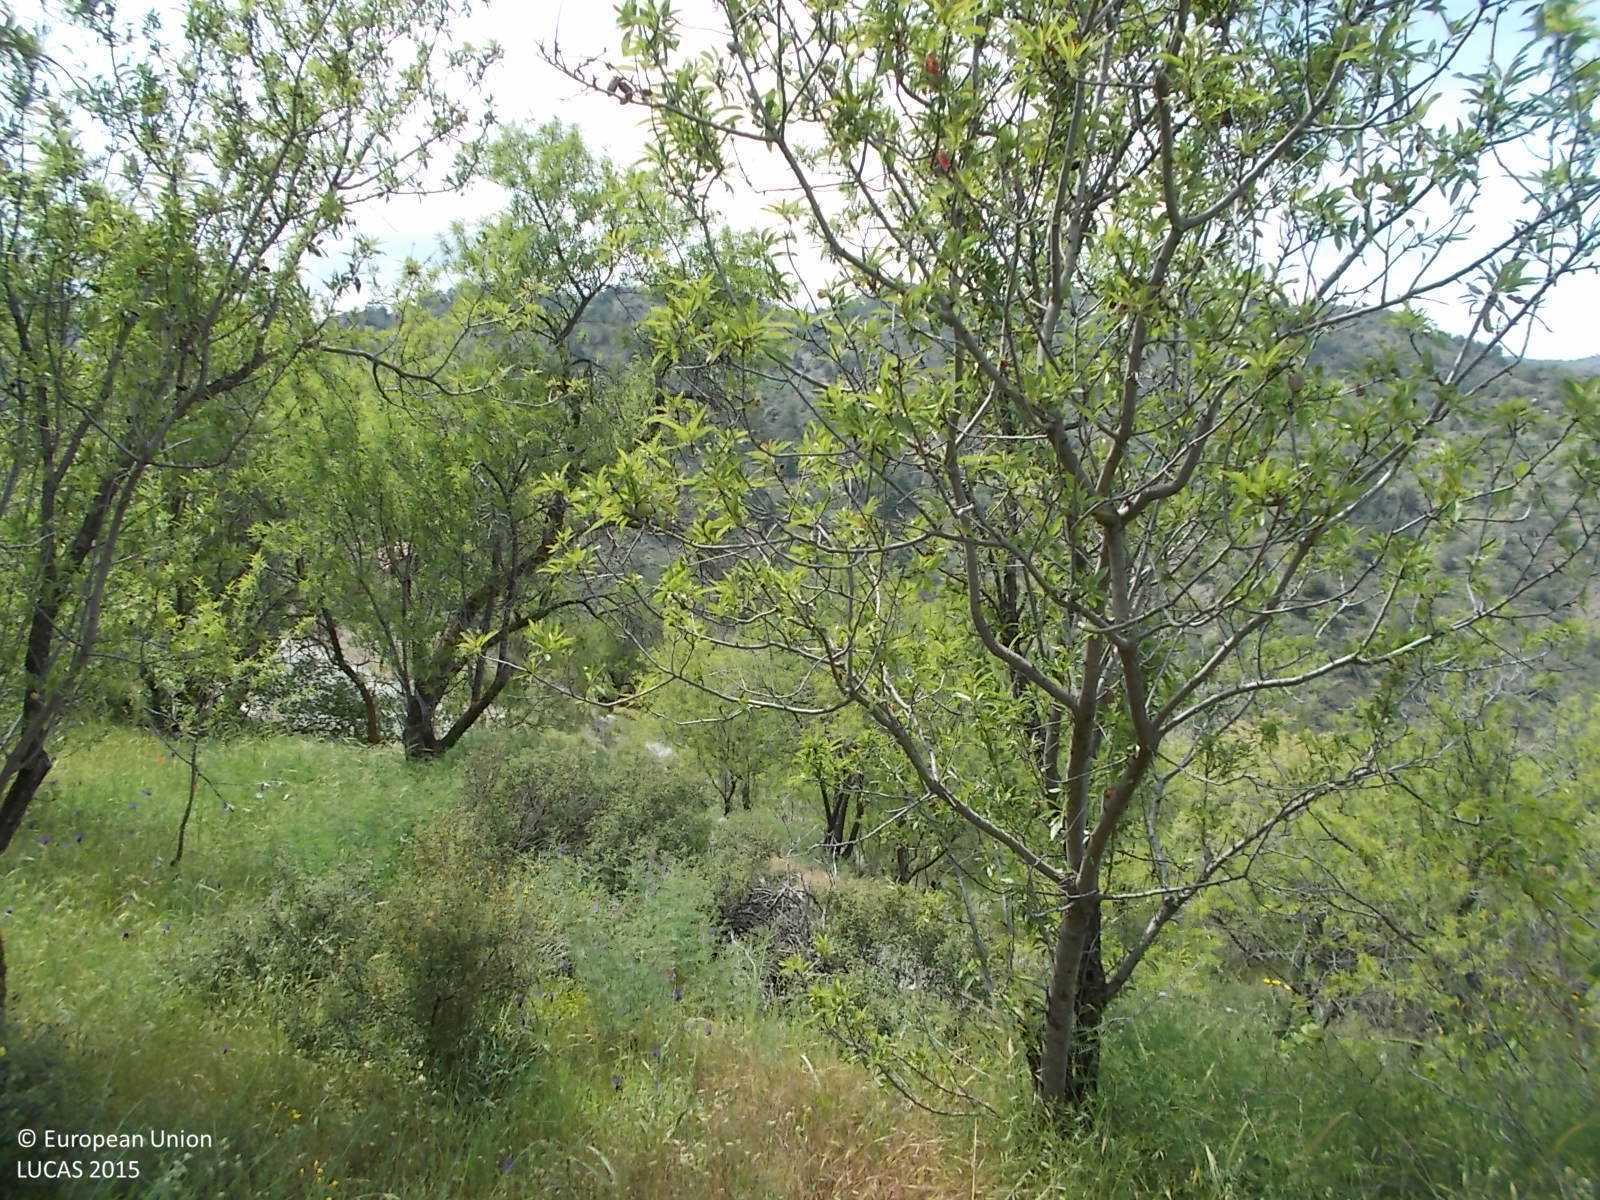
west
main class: Cropland
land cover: Nuts trees
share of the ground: > 75 %
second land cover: Grassland without tree/shrub cover
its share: > 75 %
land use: Abandoned areas
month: May
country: CY
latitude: 34.9449
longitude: 33.0700
